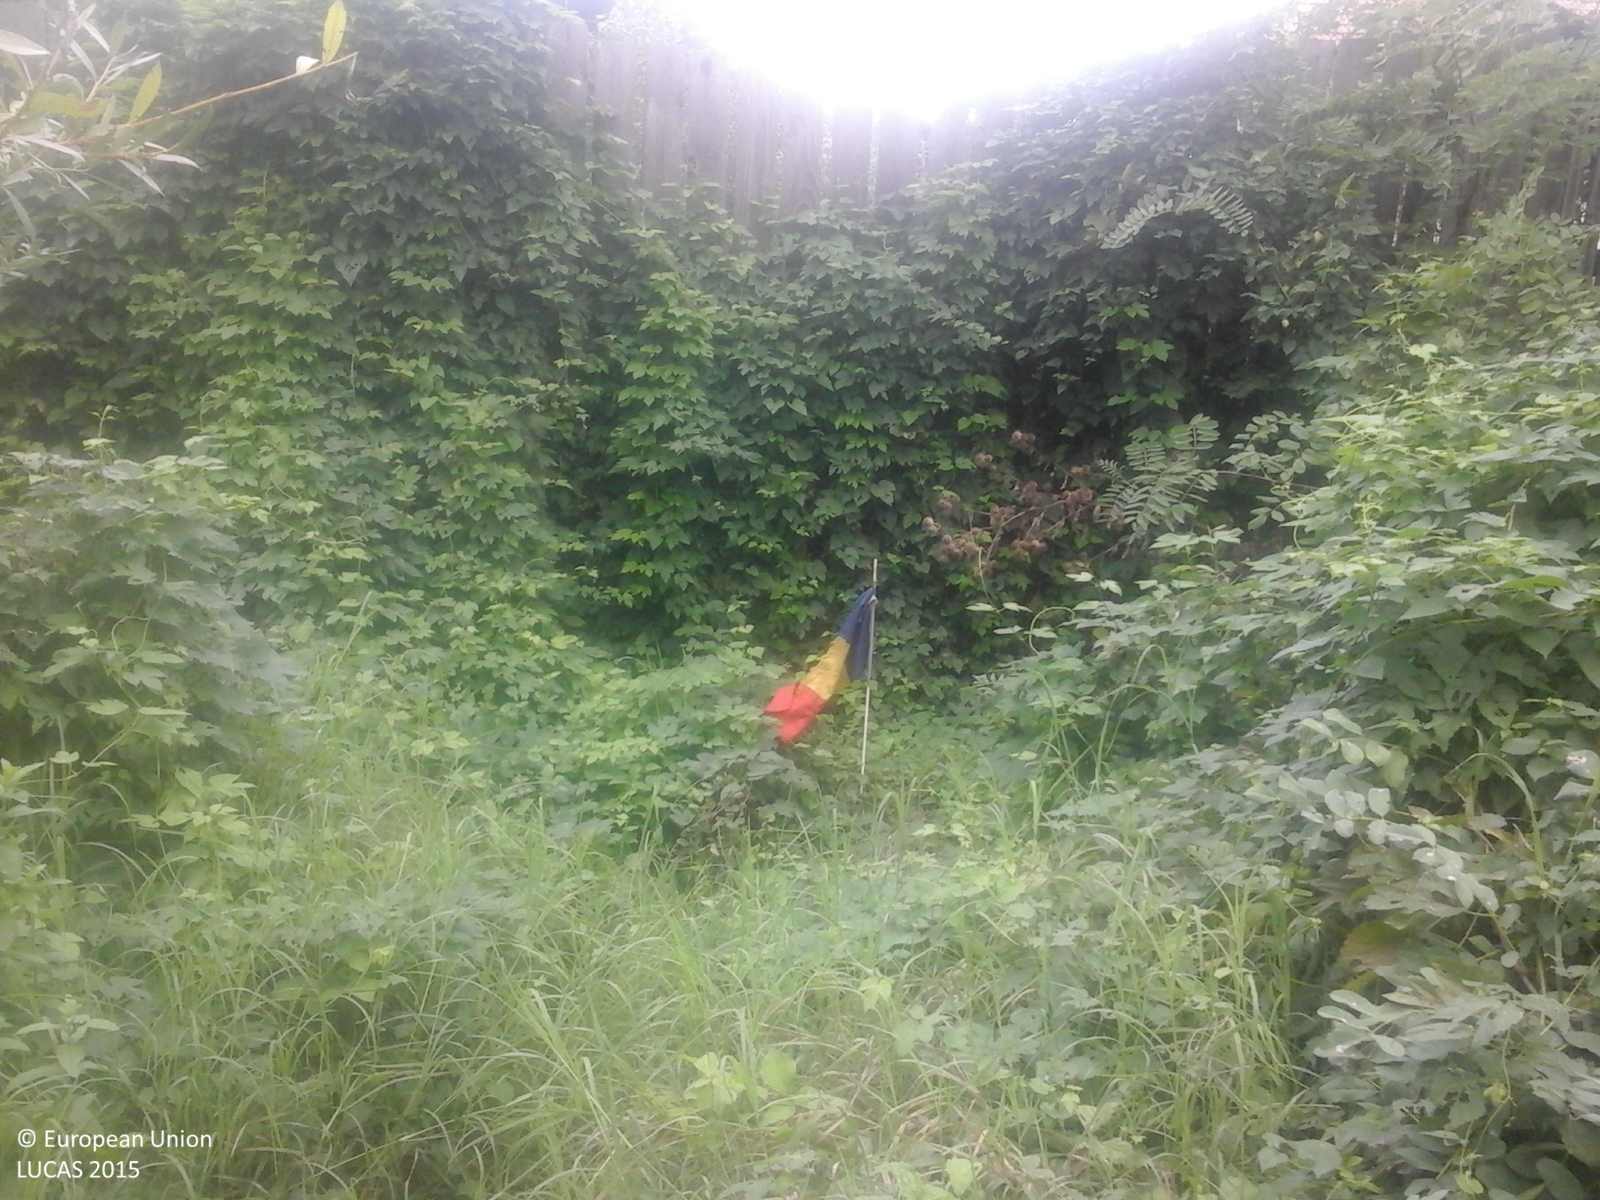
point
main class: Woodland
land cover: Broadleaved woodland
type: exotic forest
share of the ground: > 75 %
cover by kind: broadleaved forest trees 100 %
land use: Forestry
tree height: > 5 m
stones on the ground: < 10 %
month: September
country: RO
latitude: 44.8072
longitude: 24.2423
